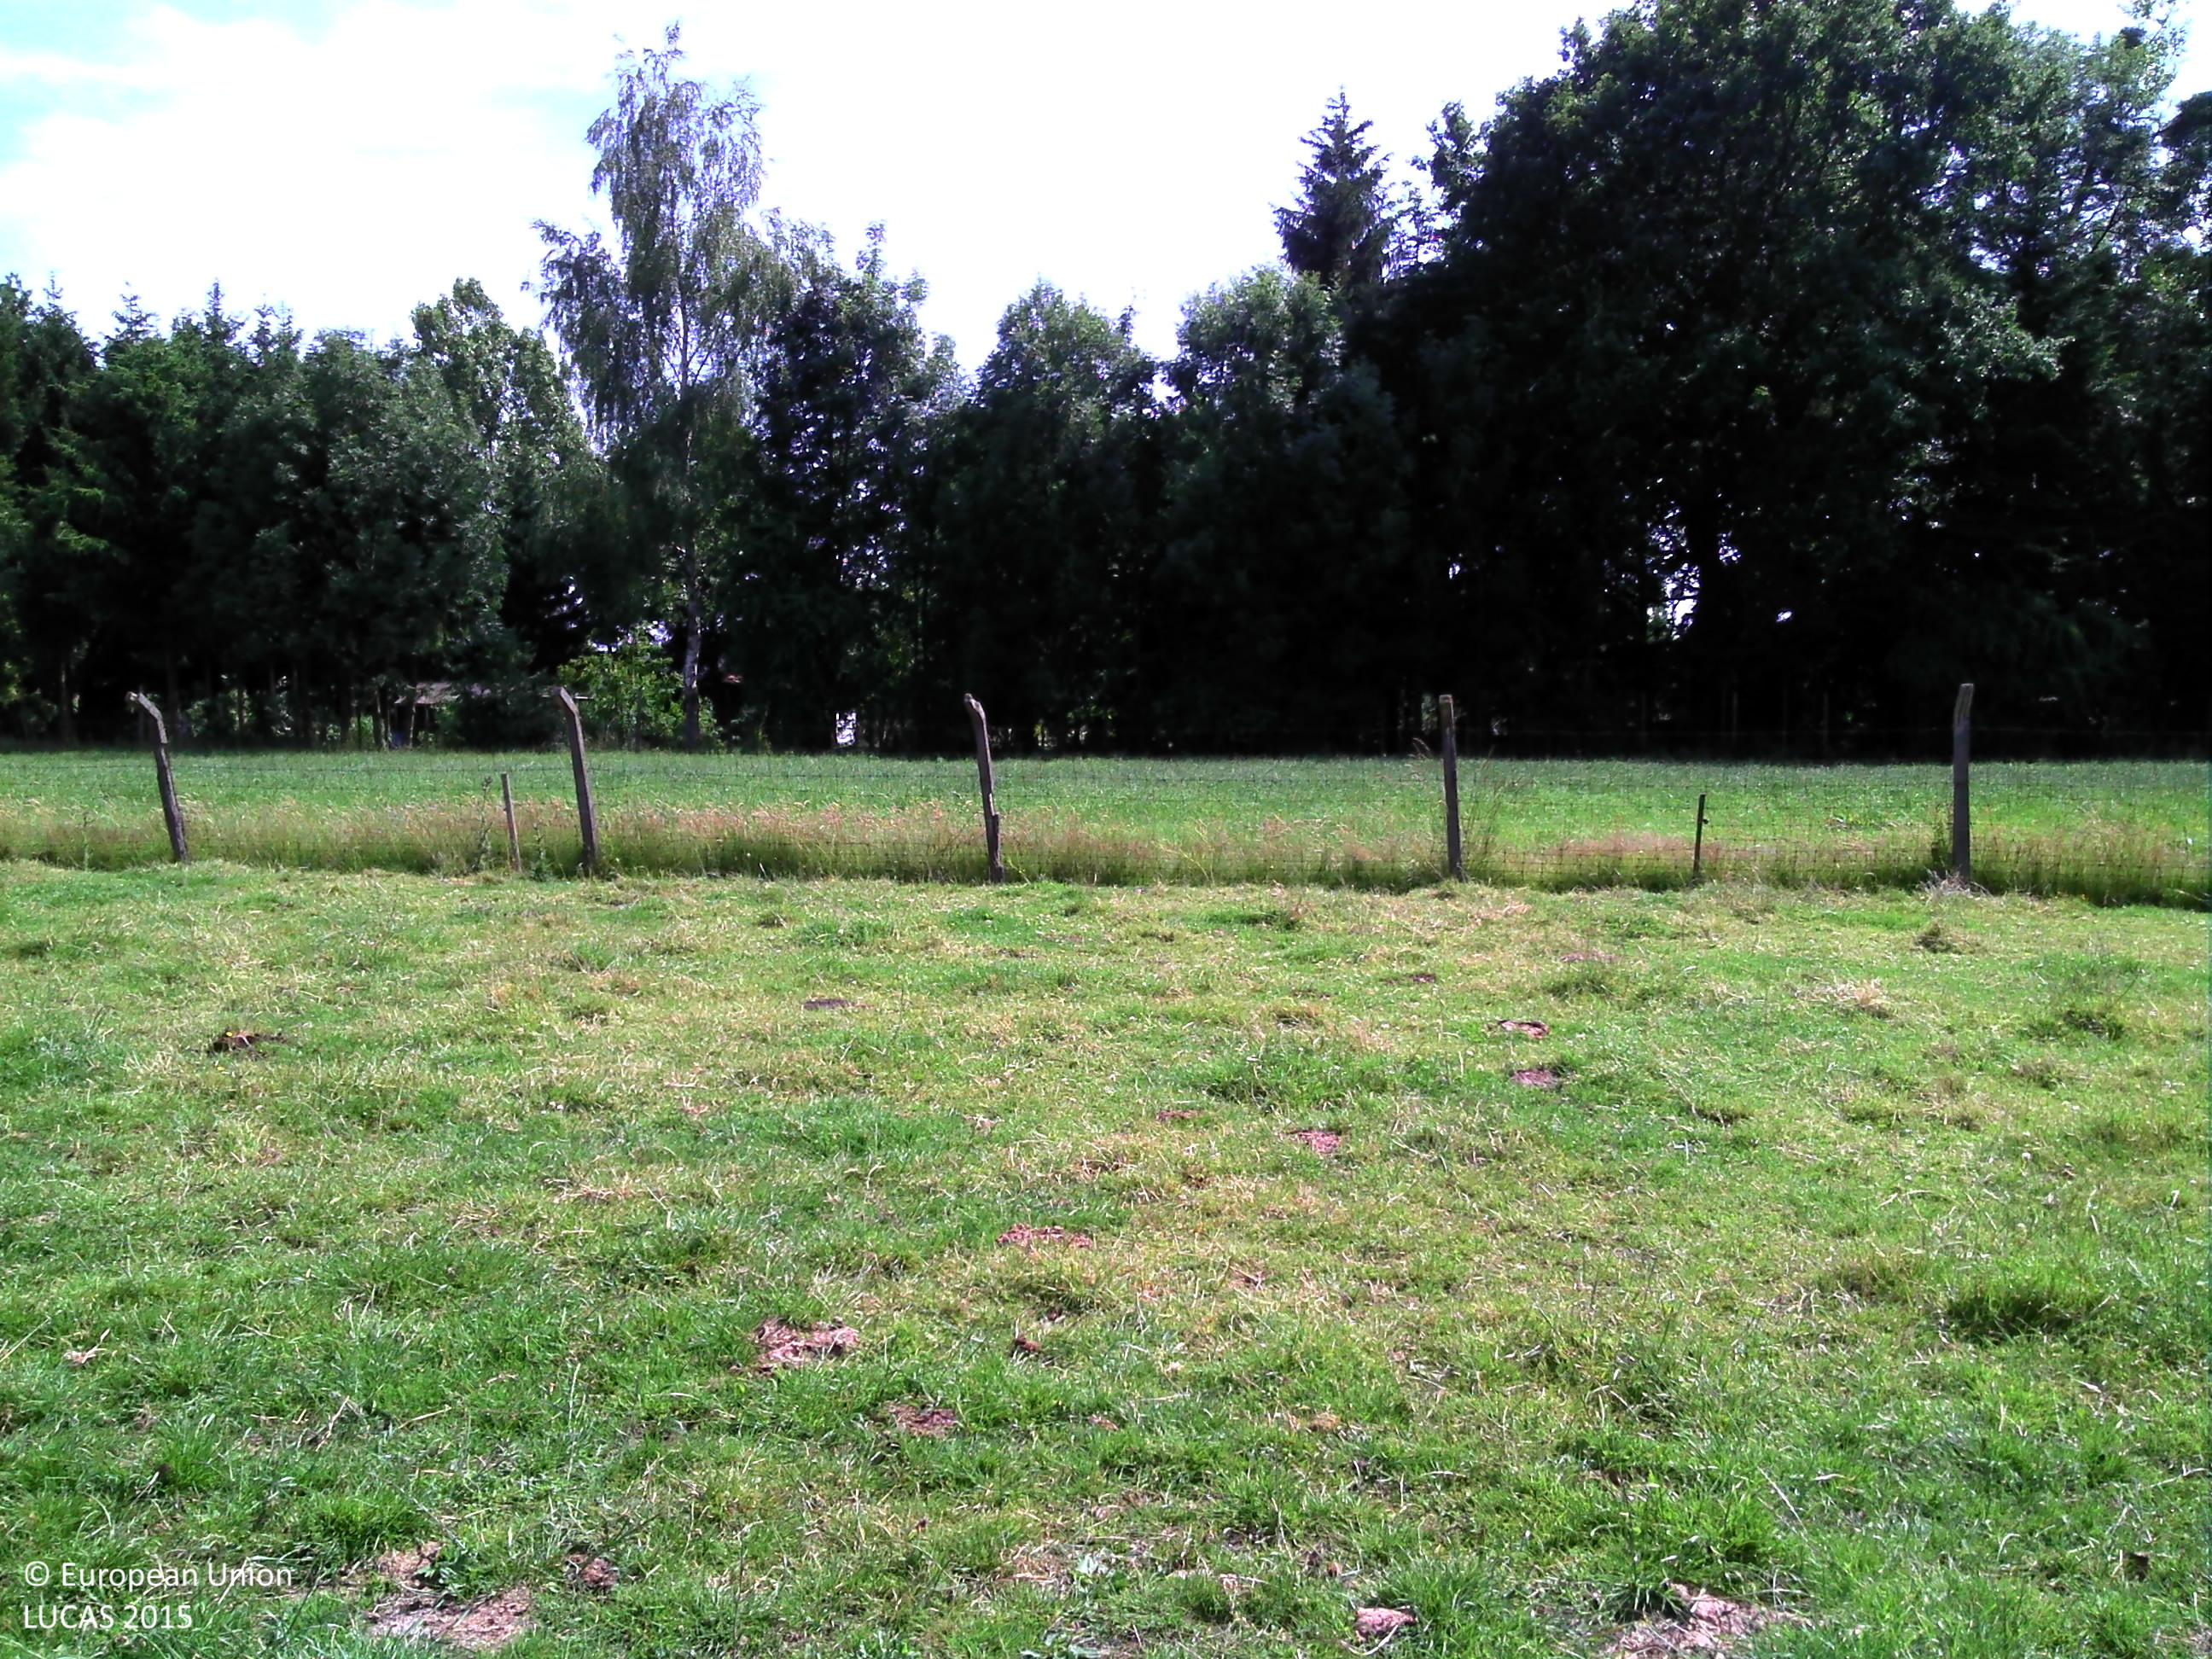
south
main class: Grassland
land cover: Grassland without tree/shrub cover
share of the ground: > 75 %
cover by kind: herbaceous plants 100 %
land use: Agriculture (excluding fallow land and kitchen gardens)
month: June
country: BE
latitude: 50.8729
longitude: 5.5787
